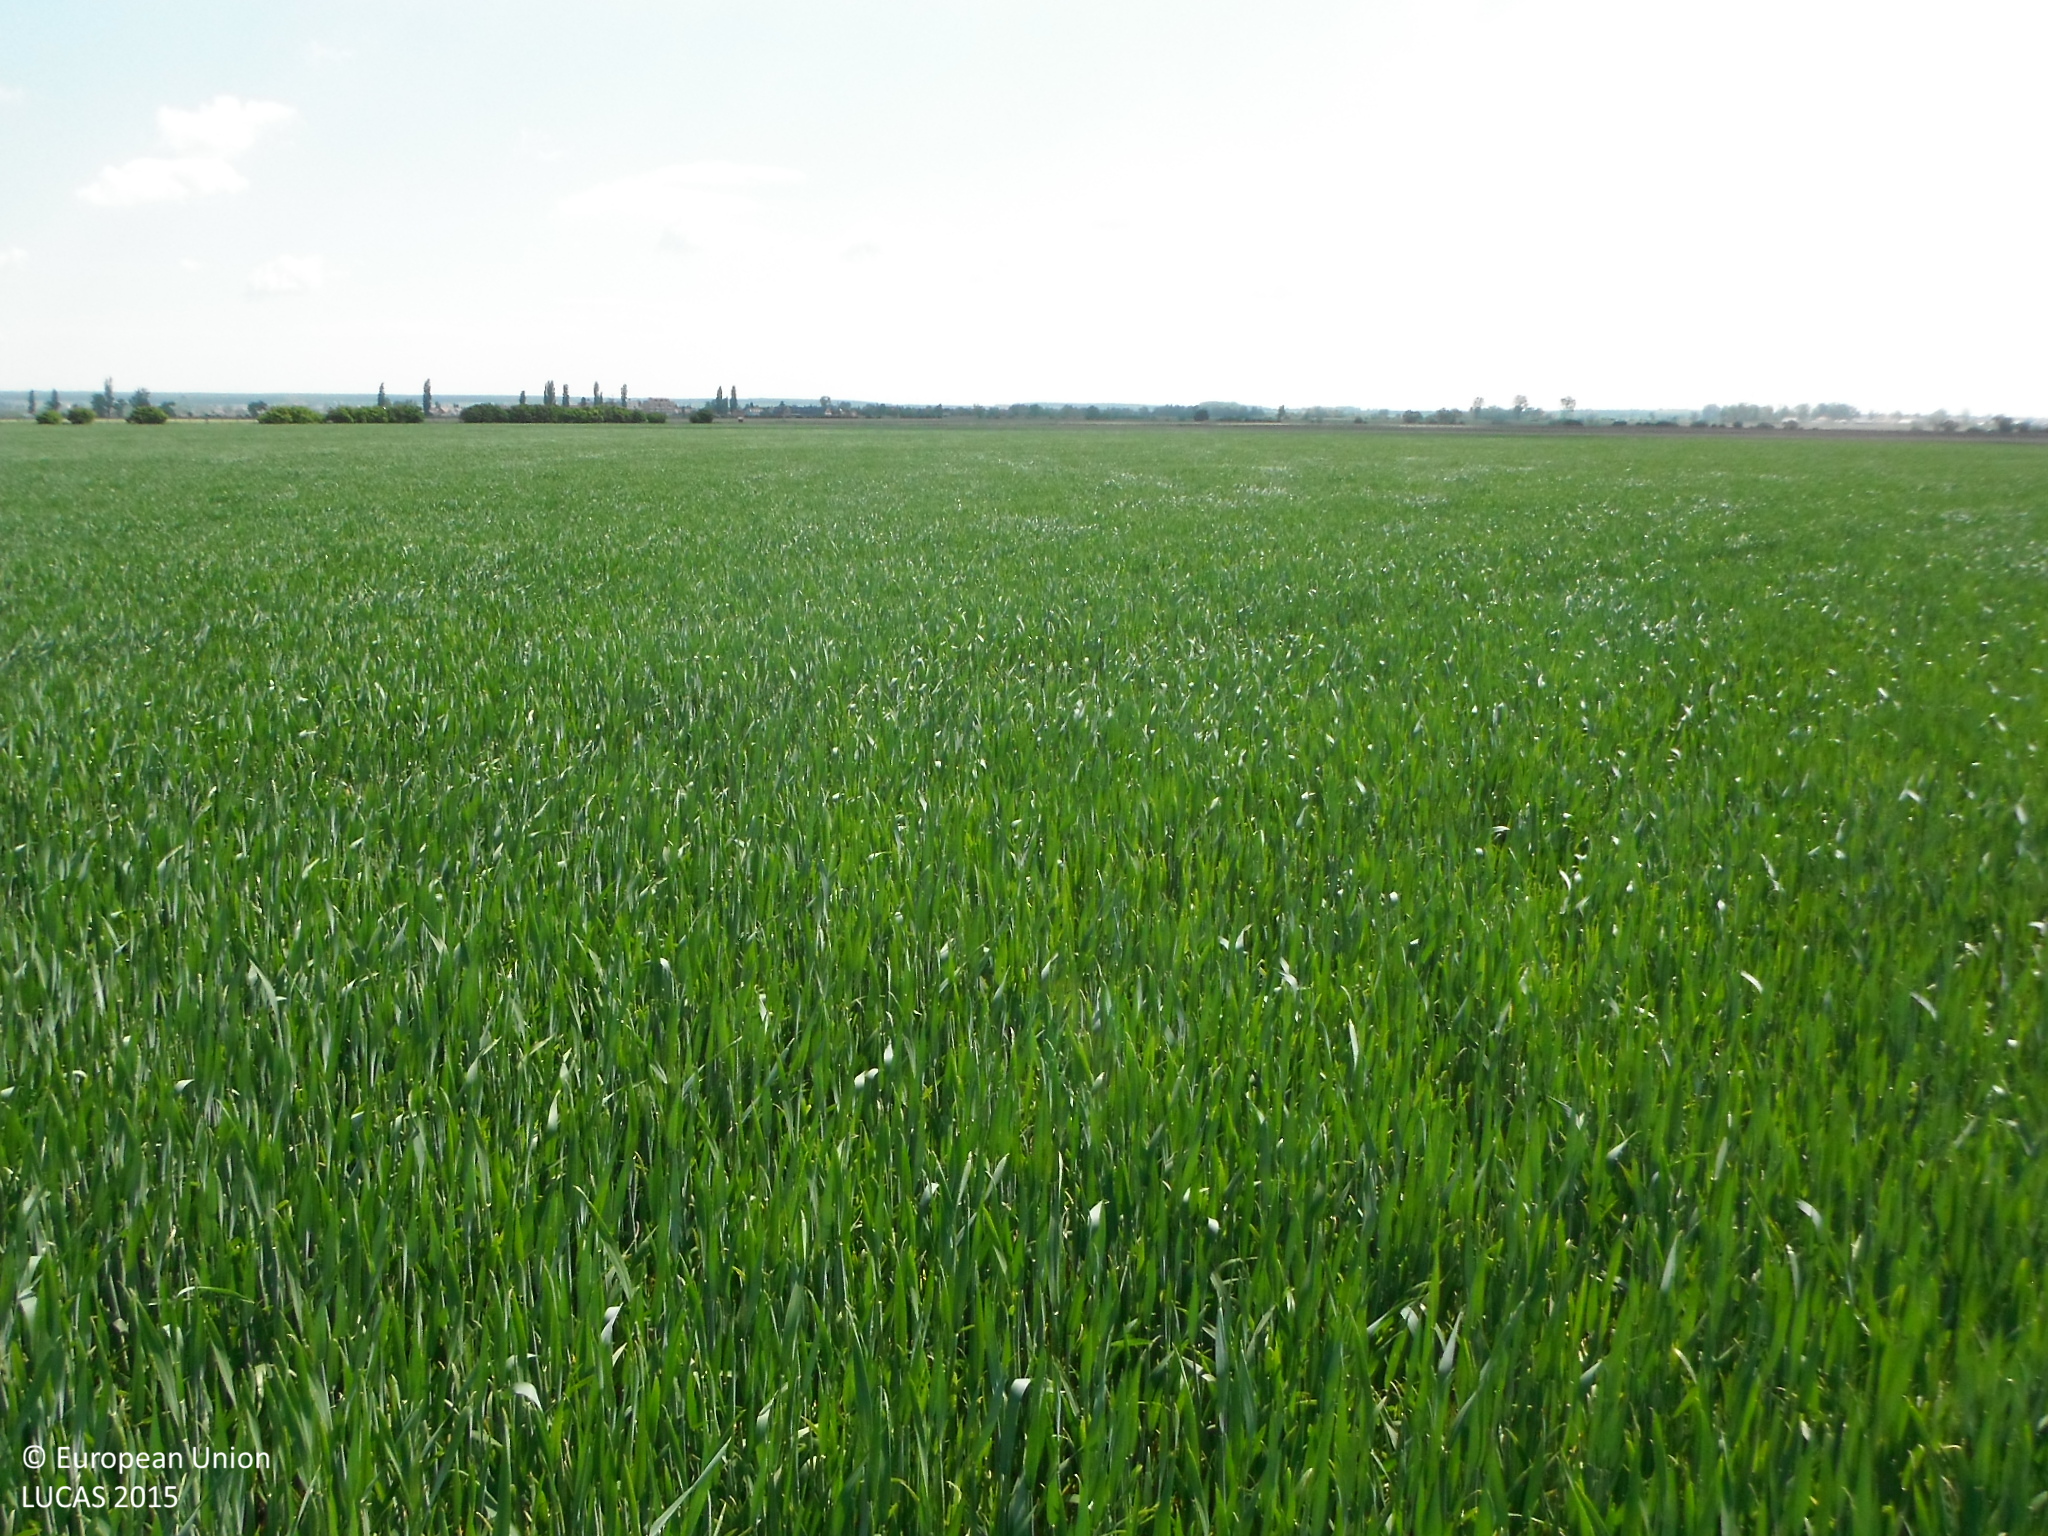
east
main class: Cropland
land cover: Common wheat
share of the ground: > 75 %
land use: Agriculture (excluding fallow land and kitchen gardens)
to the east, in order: Common wheat
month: May
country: SK
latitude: 48.2562
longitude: 17.2418
